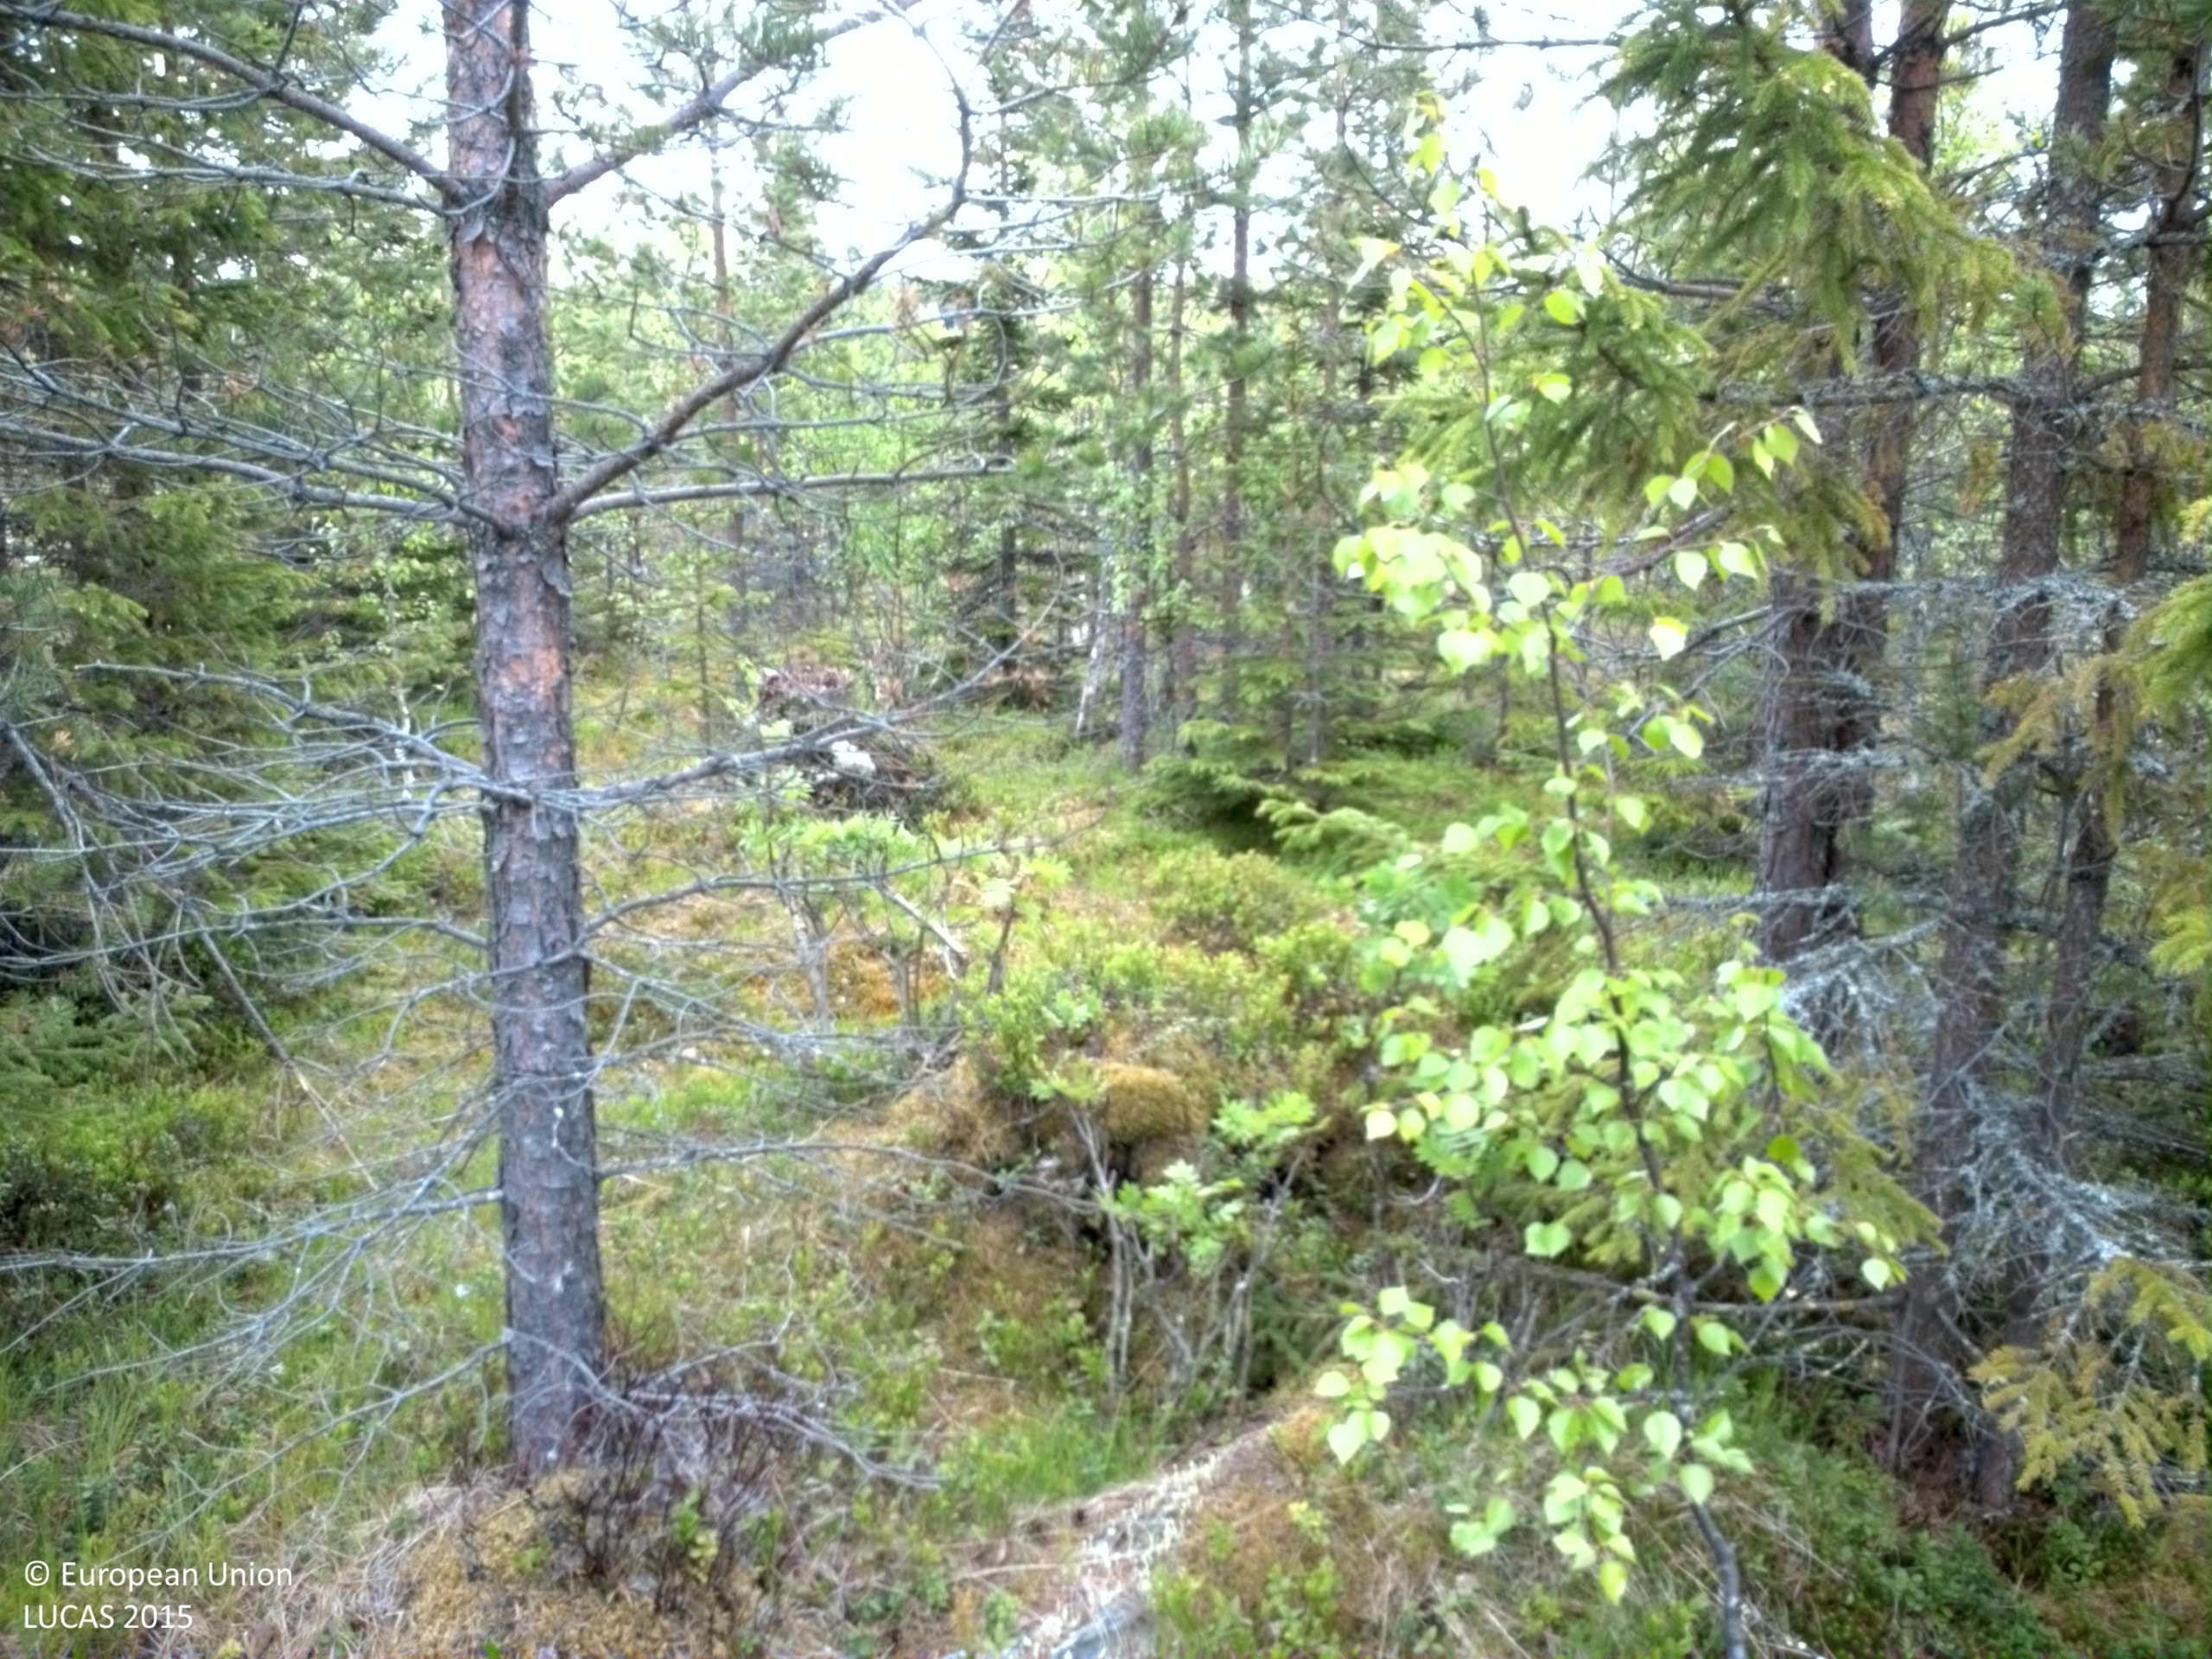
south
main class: Woodland
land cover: Pine dominated mixed woodland
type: boreal forest
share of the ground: 50 - 75 %
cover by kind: coniferous forest trees 45 %, shrubs 40 %, broadleaved forest trees 15 %
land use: Forestry
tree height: < 5 m
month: June
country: SE
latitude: 63.1626
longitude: 17.9782
